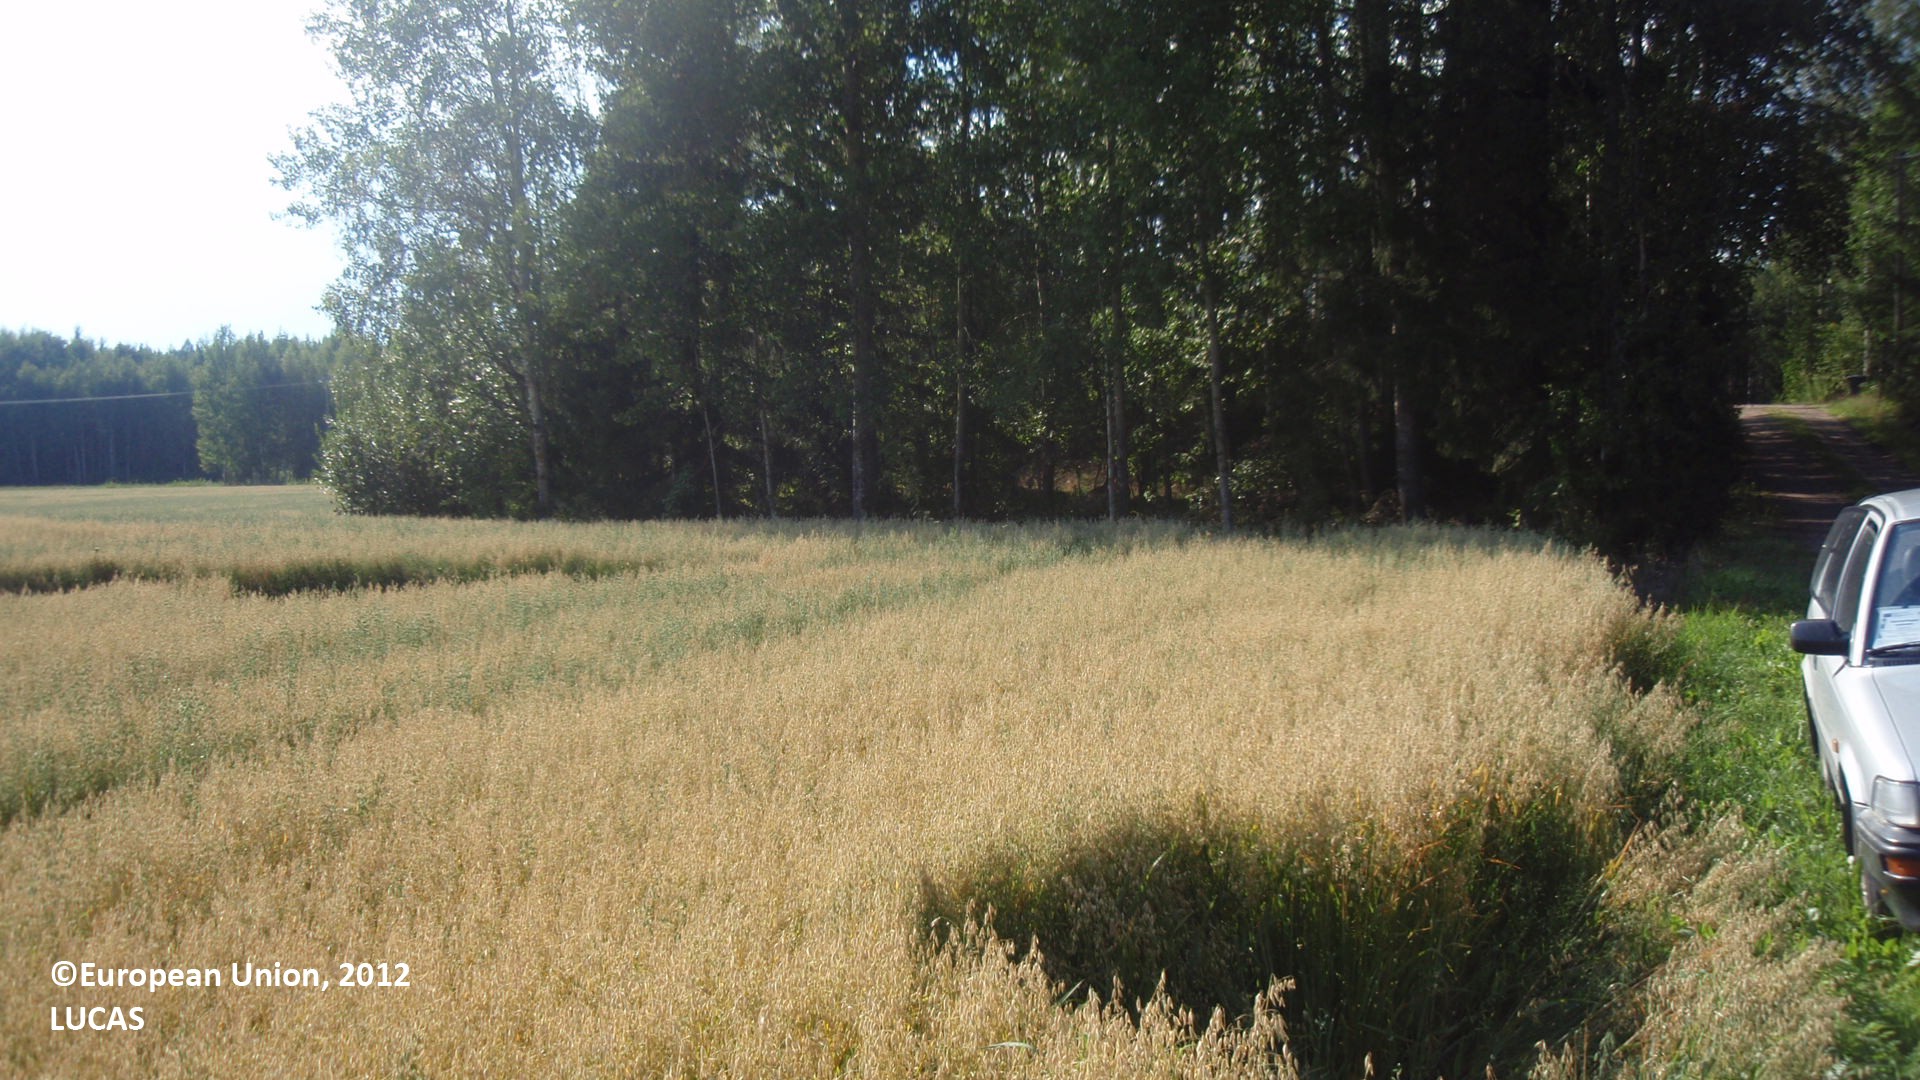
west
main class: Cropland
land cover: Oats
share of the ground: > 75 %
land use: Agriculture (excluding fallow land and kitchen gardens)
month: August
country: FI
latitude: 60.8104
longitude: 26.6080
